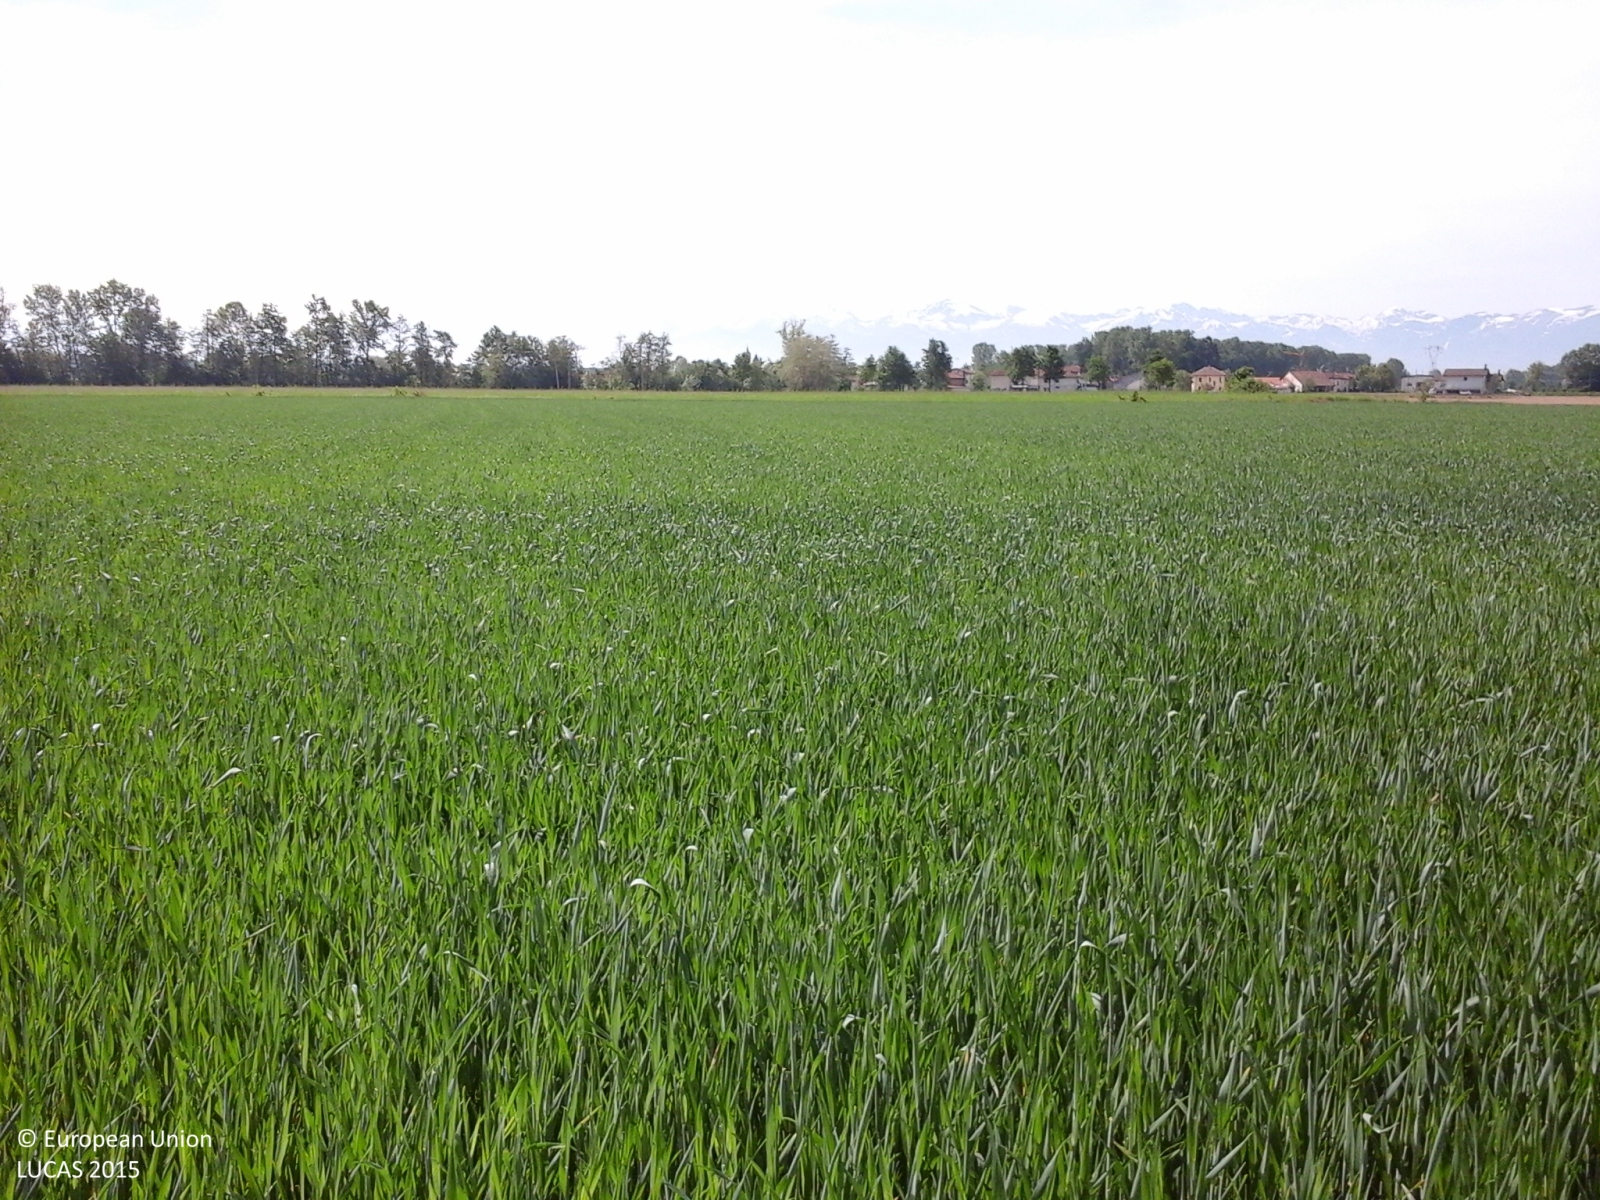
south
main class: Cropland
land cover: Common wheat
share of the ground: > 75 %
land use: Agriculture (excluding fallow land and kitchen gardens)
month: May
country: IT
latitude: 44.5072
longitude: 7.7782
